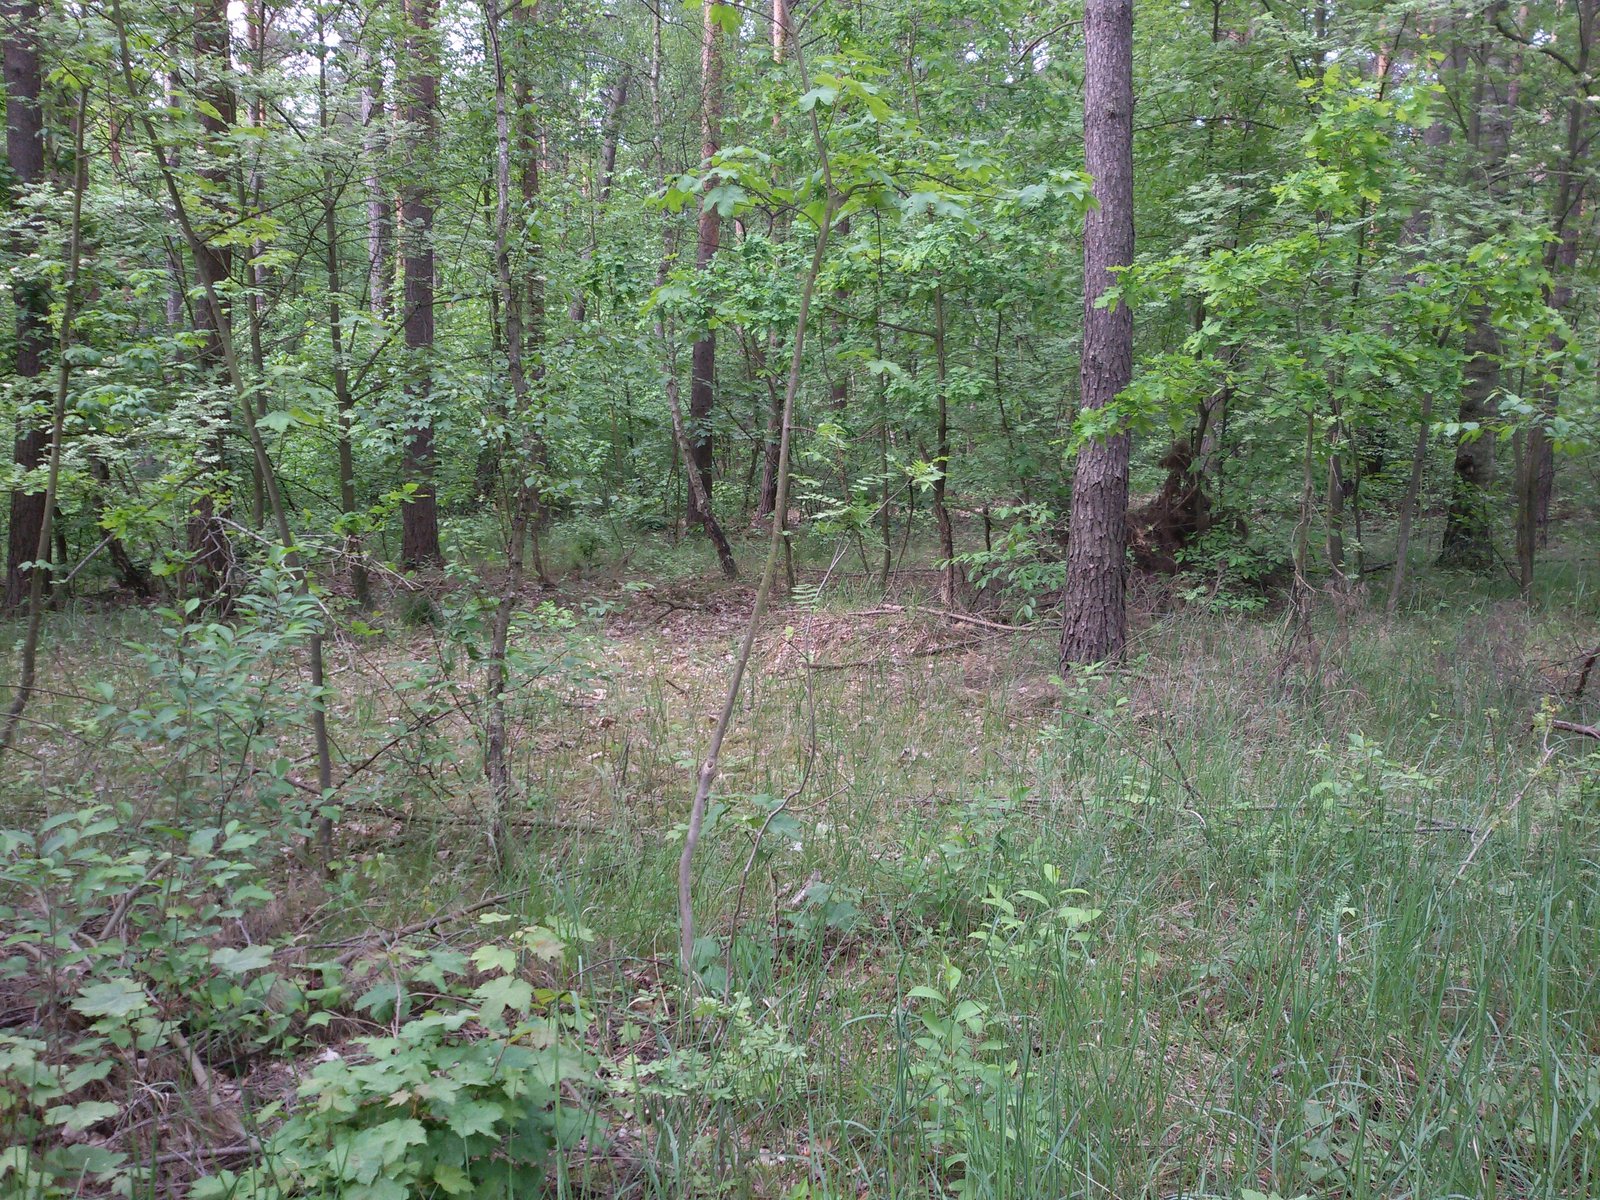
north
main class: Woodland
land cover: Pine dominated mixed woodland
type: hemiboreal forest and nemoral coniferous forest and mixed broadleaved-coniferous forest
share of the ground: > 75 %
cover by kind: coniferous forest trees 60 %, broadleaved forest trees 25 %, herbaceous plants 15 %
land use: Forestry
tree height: > 5 m
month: May
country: PL
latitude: 52.6491
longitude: 17.1496
